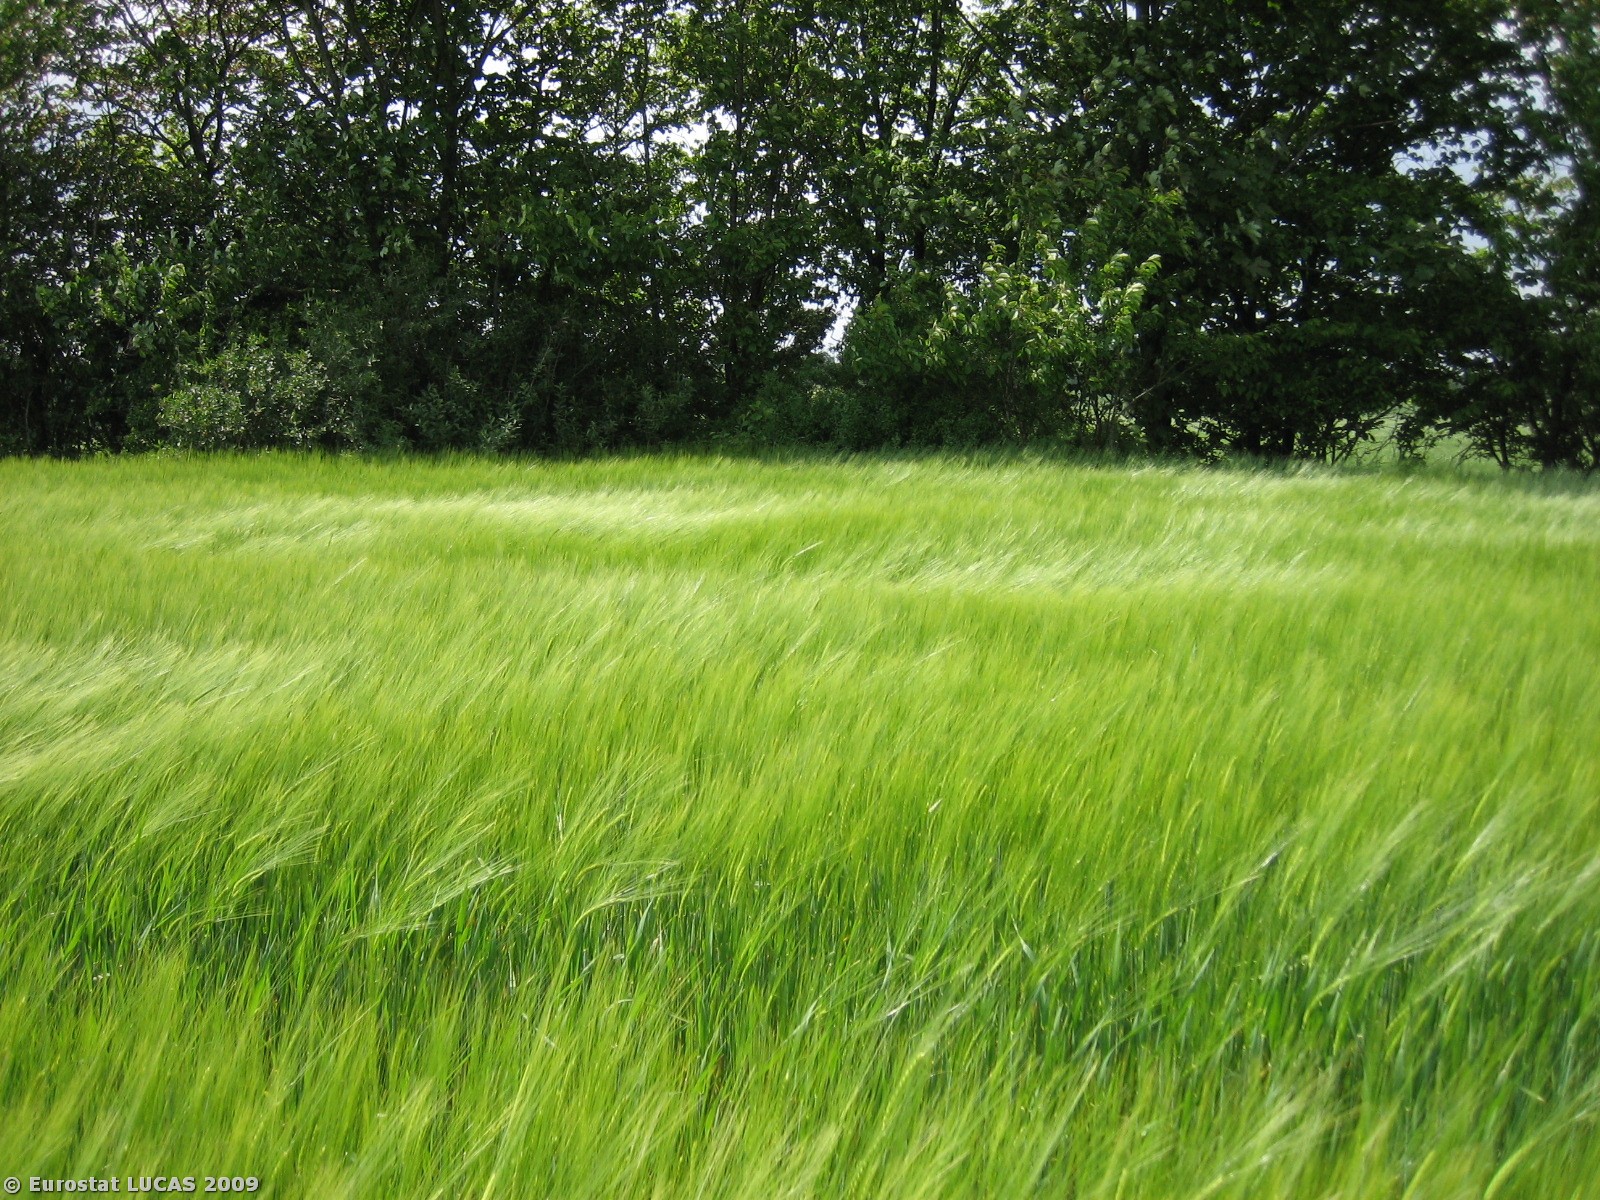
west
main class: Cropland
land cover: Barley
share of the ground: > 75 %
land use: Agriculture (excluding fallow land and kitchen gardens)
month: May
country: DK
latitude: 55.8079
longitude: 9.2190
